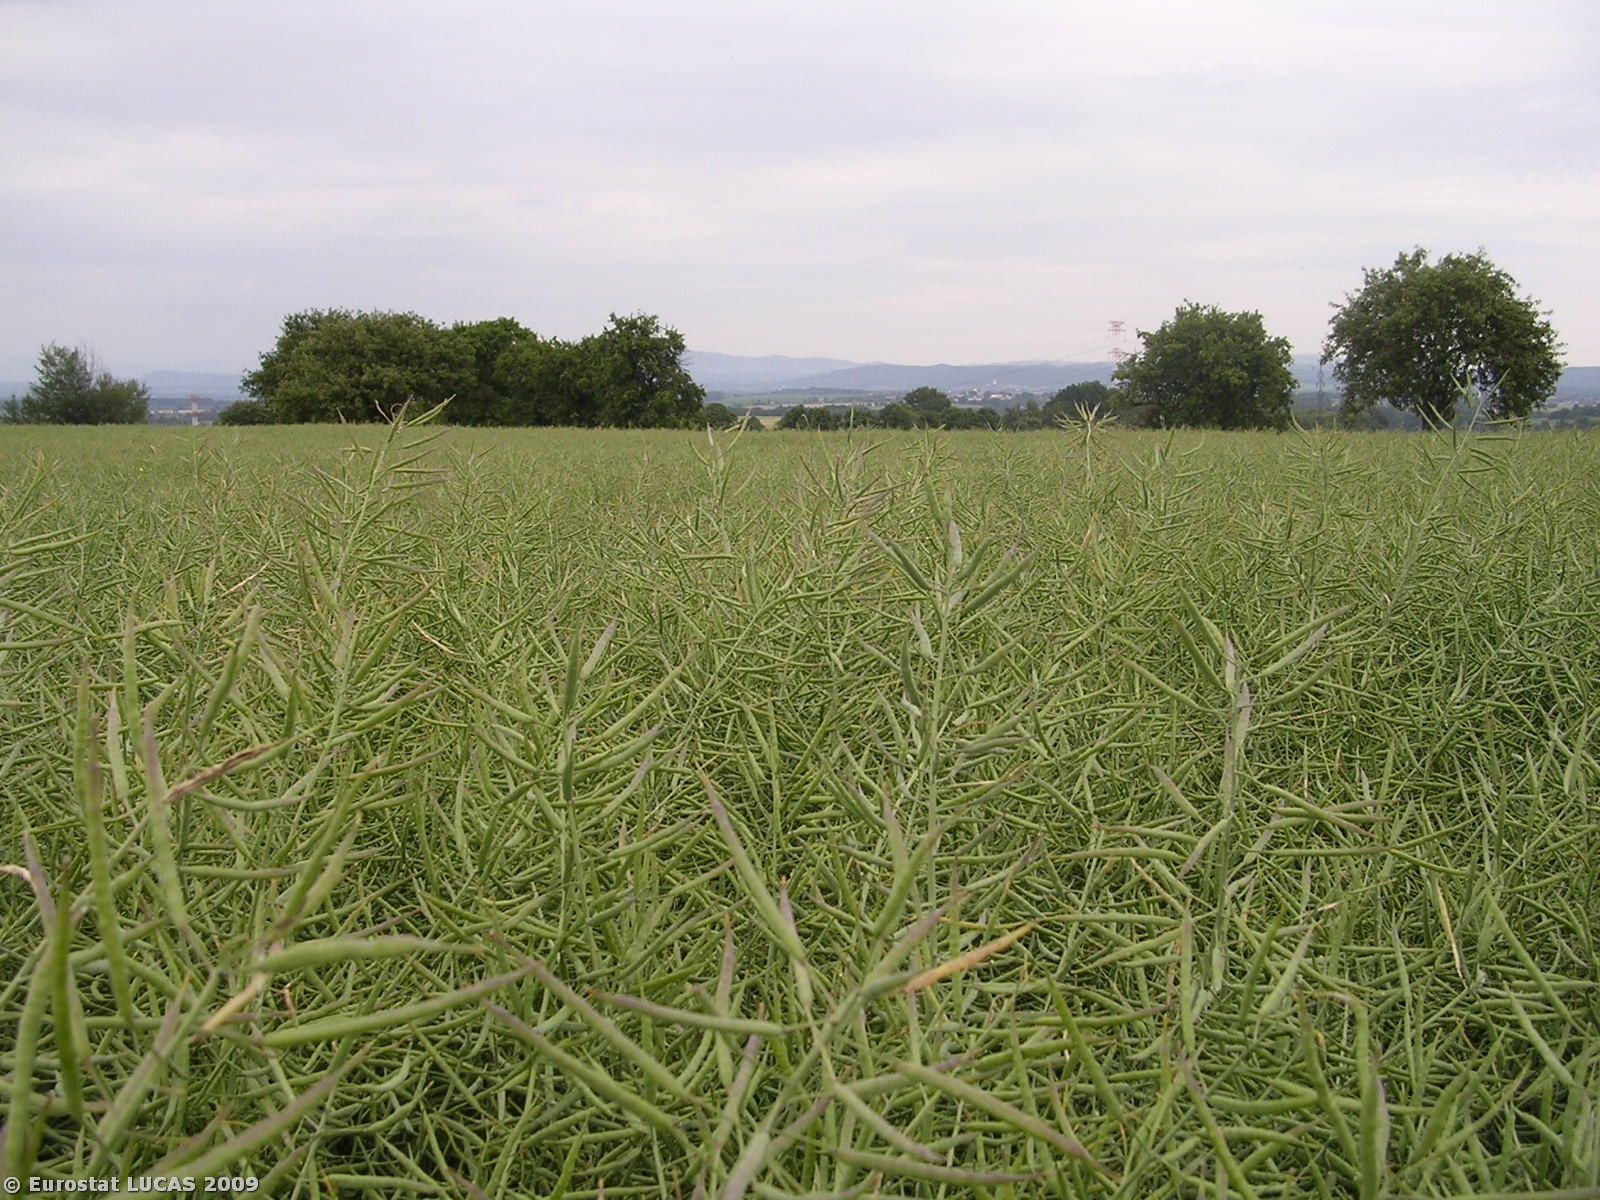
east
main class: Cropland
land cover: Rape and turnip rape
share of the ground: > 75 %
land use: Agriculture (excluding fallow land and kitchen gardens)
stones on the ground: < 10 %
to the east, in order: Rape and turnip rape; Grassland without tree/shrub cover; Paved roads, cycling and walking lanes; Lines of trees; Common wheat
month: June
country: CZ
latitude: 50.5629
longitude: 14.9579
